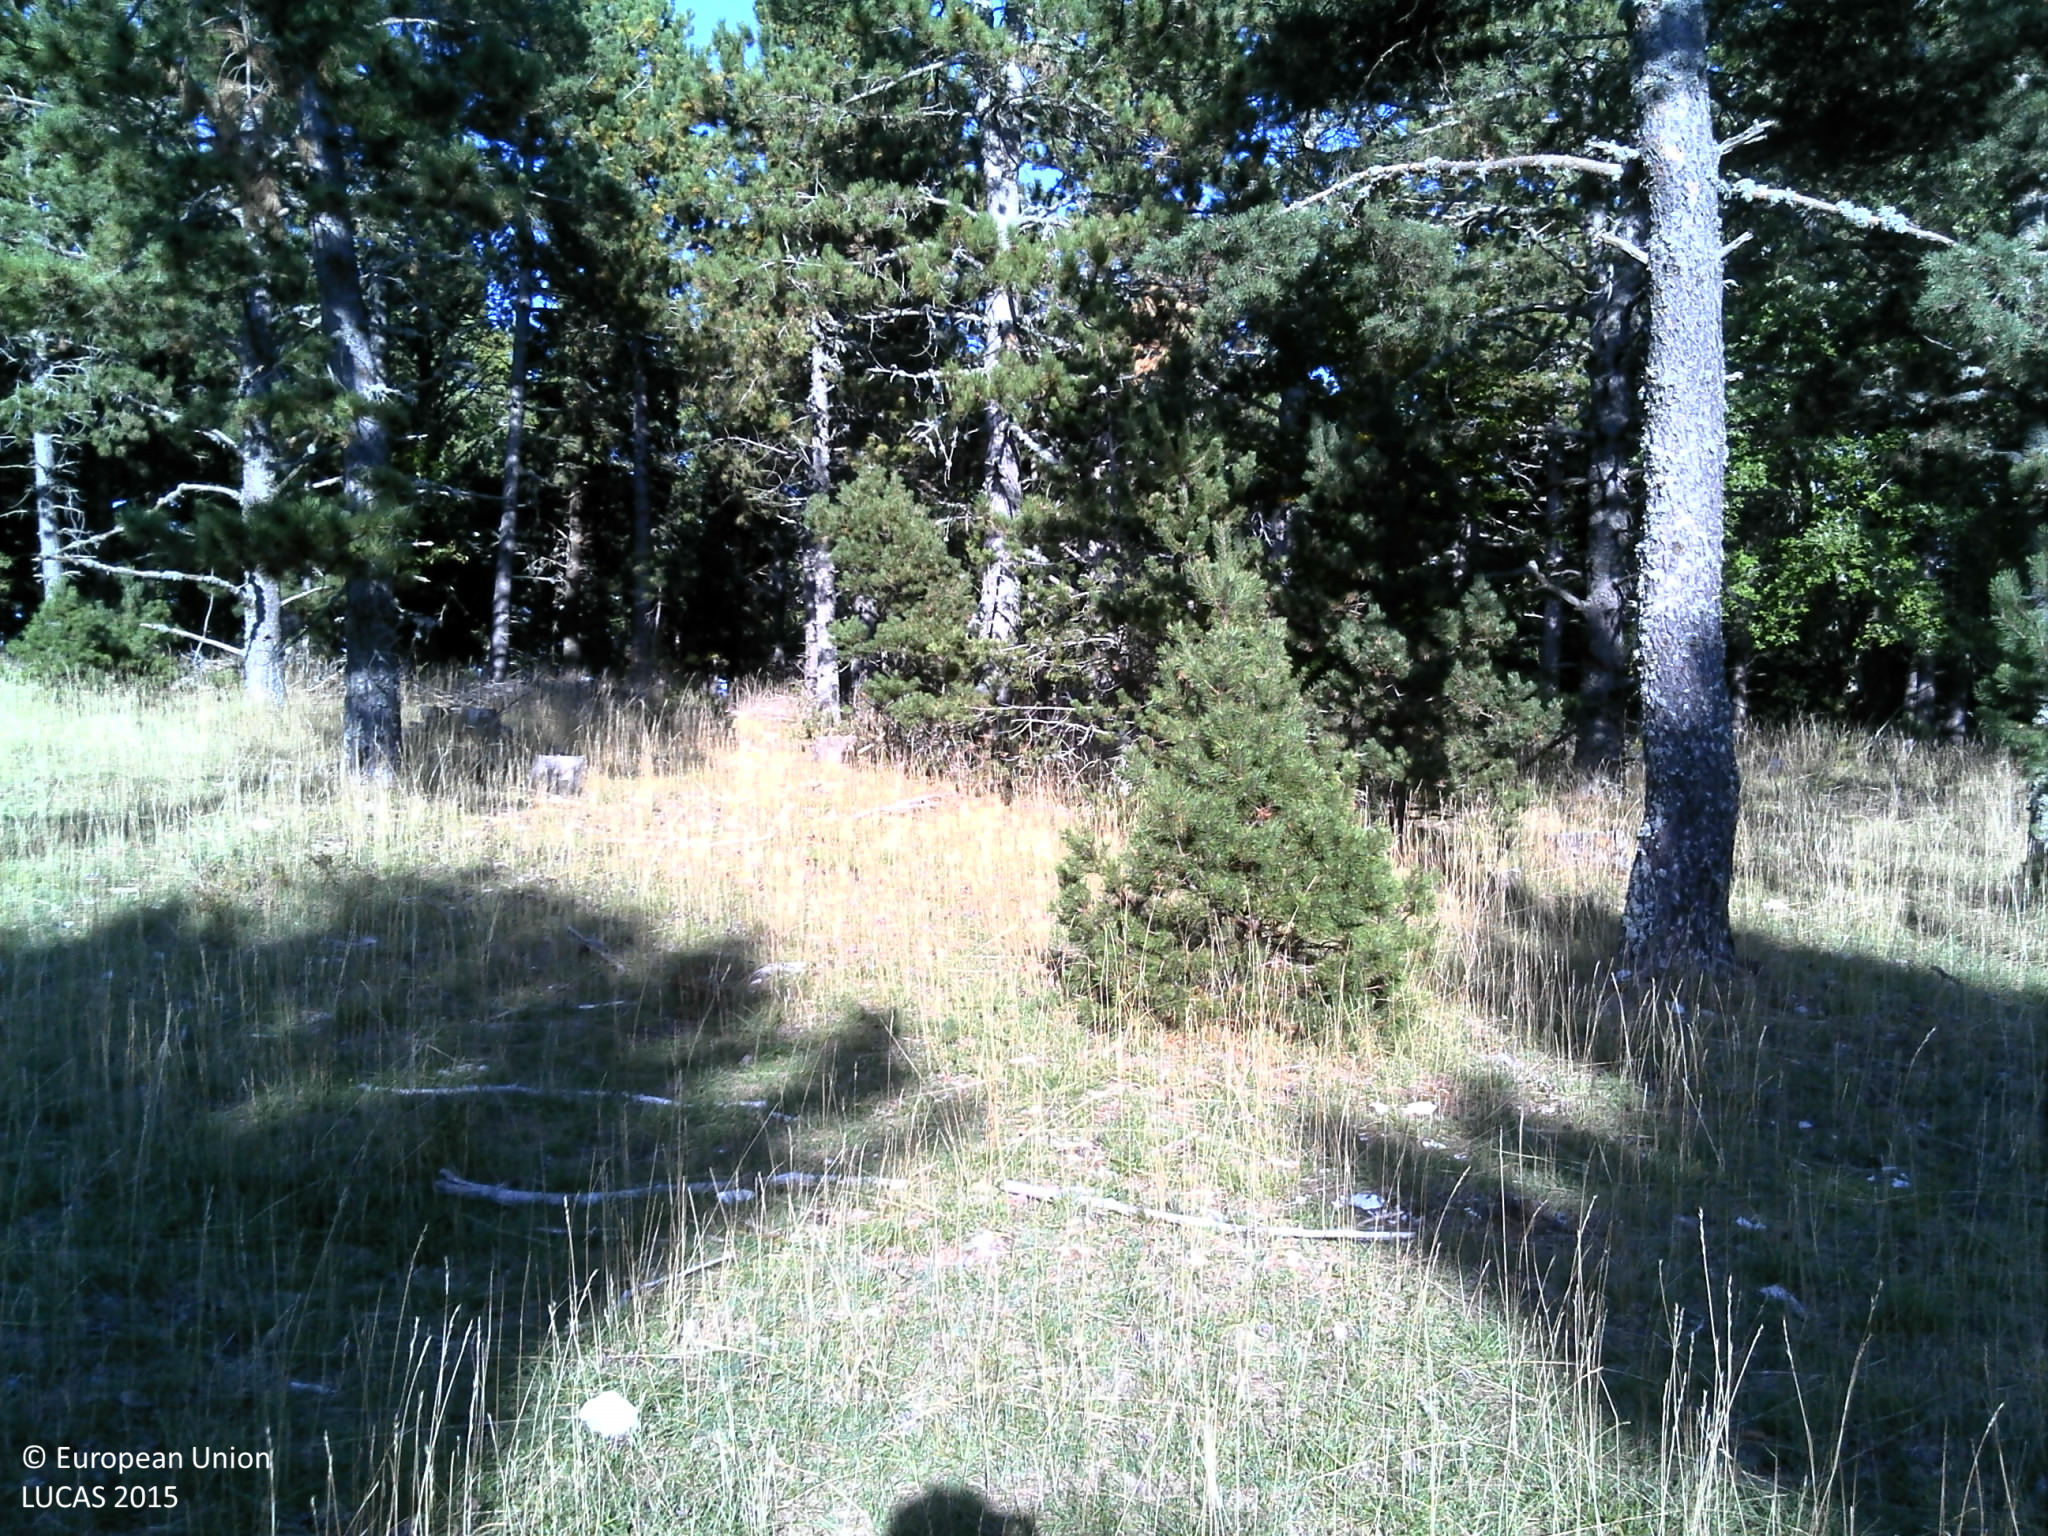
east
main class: Woodland
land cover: Other coniferous woodland
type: alpine coniferous forest
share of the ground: > 75 %
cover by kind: coniferous forest trees 70 %, herbaceous plants 30 %
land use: Forestry
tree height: > 5 m
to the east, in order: Other coniferous woodland; Pine dominated mixed woodland
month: September
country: FR
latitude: 44.1378
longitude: 5.3456
